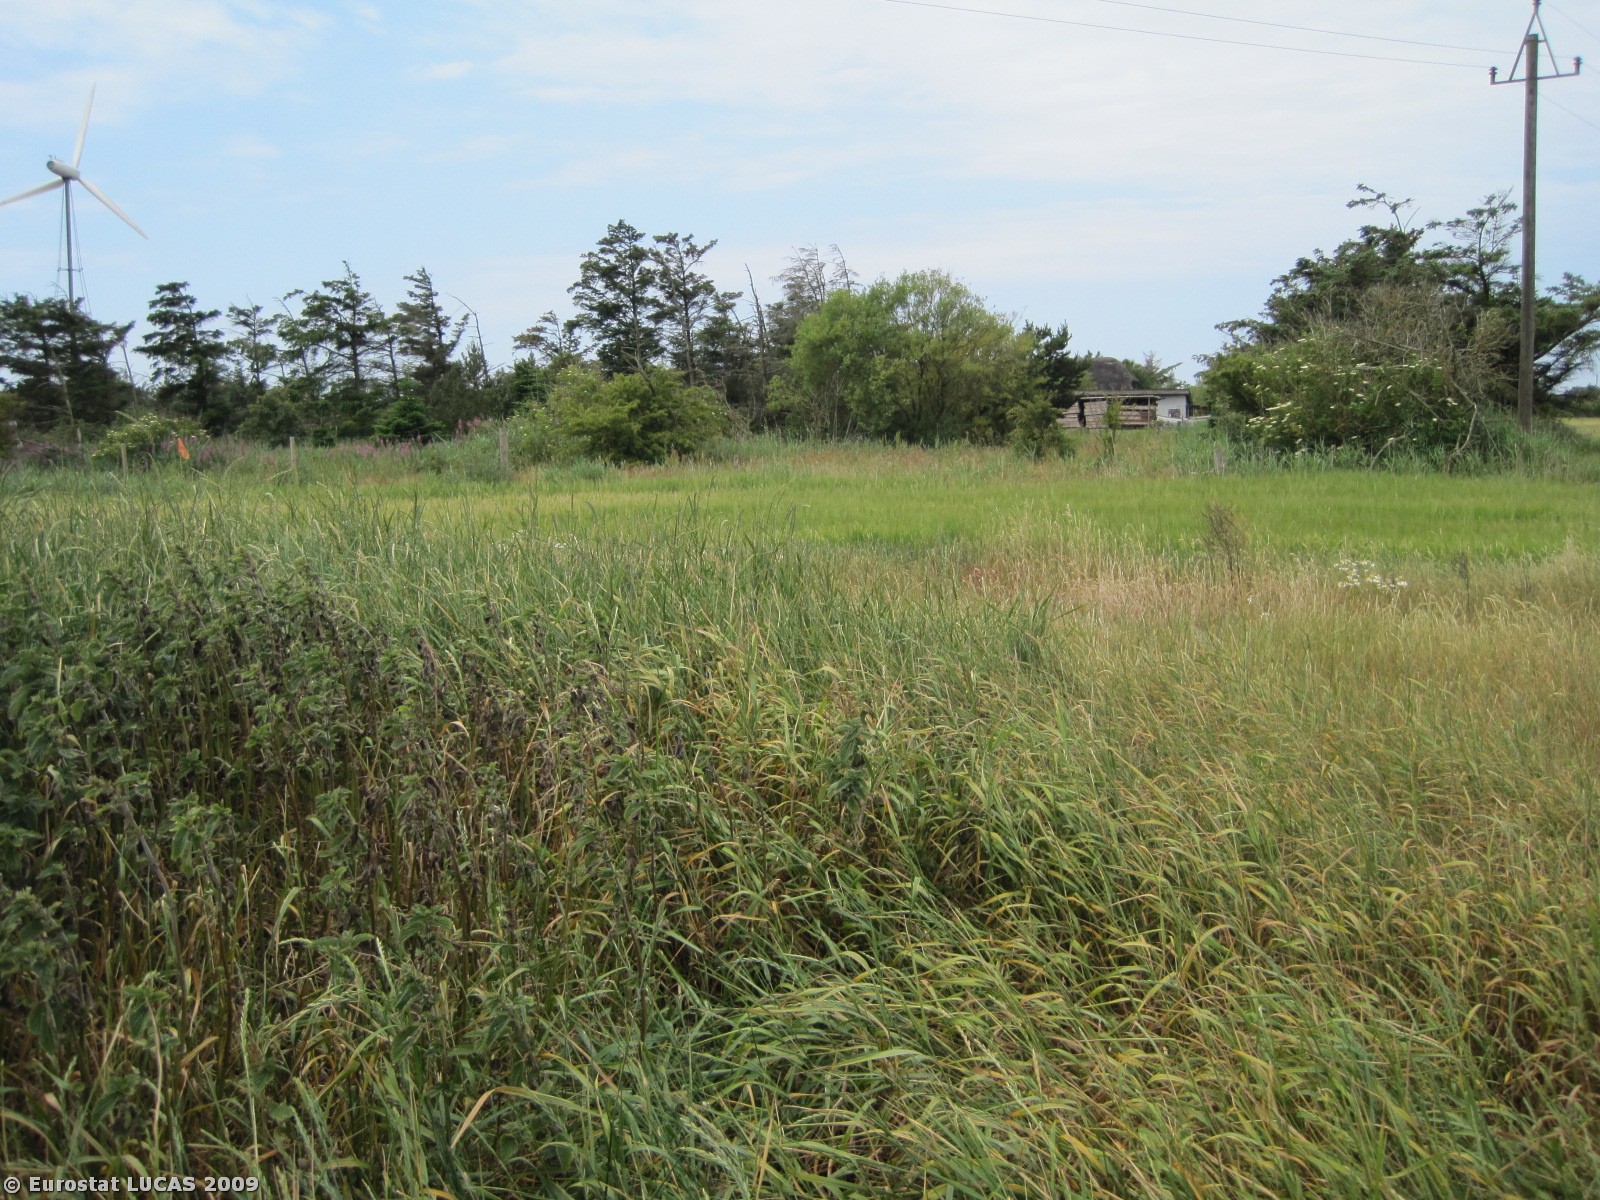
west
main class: Grassland
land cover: Grassland without tree/shrub cover
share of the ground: > 75 %
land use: Unused
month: June
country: DK
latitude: 56.6061
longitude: 8.1614
